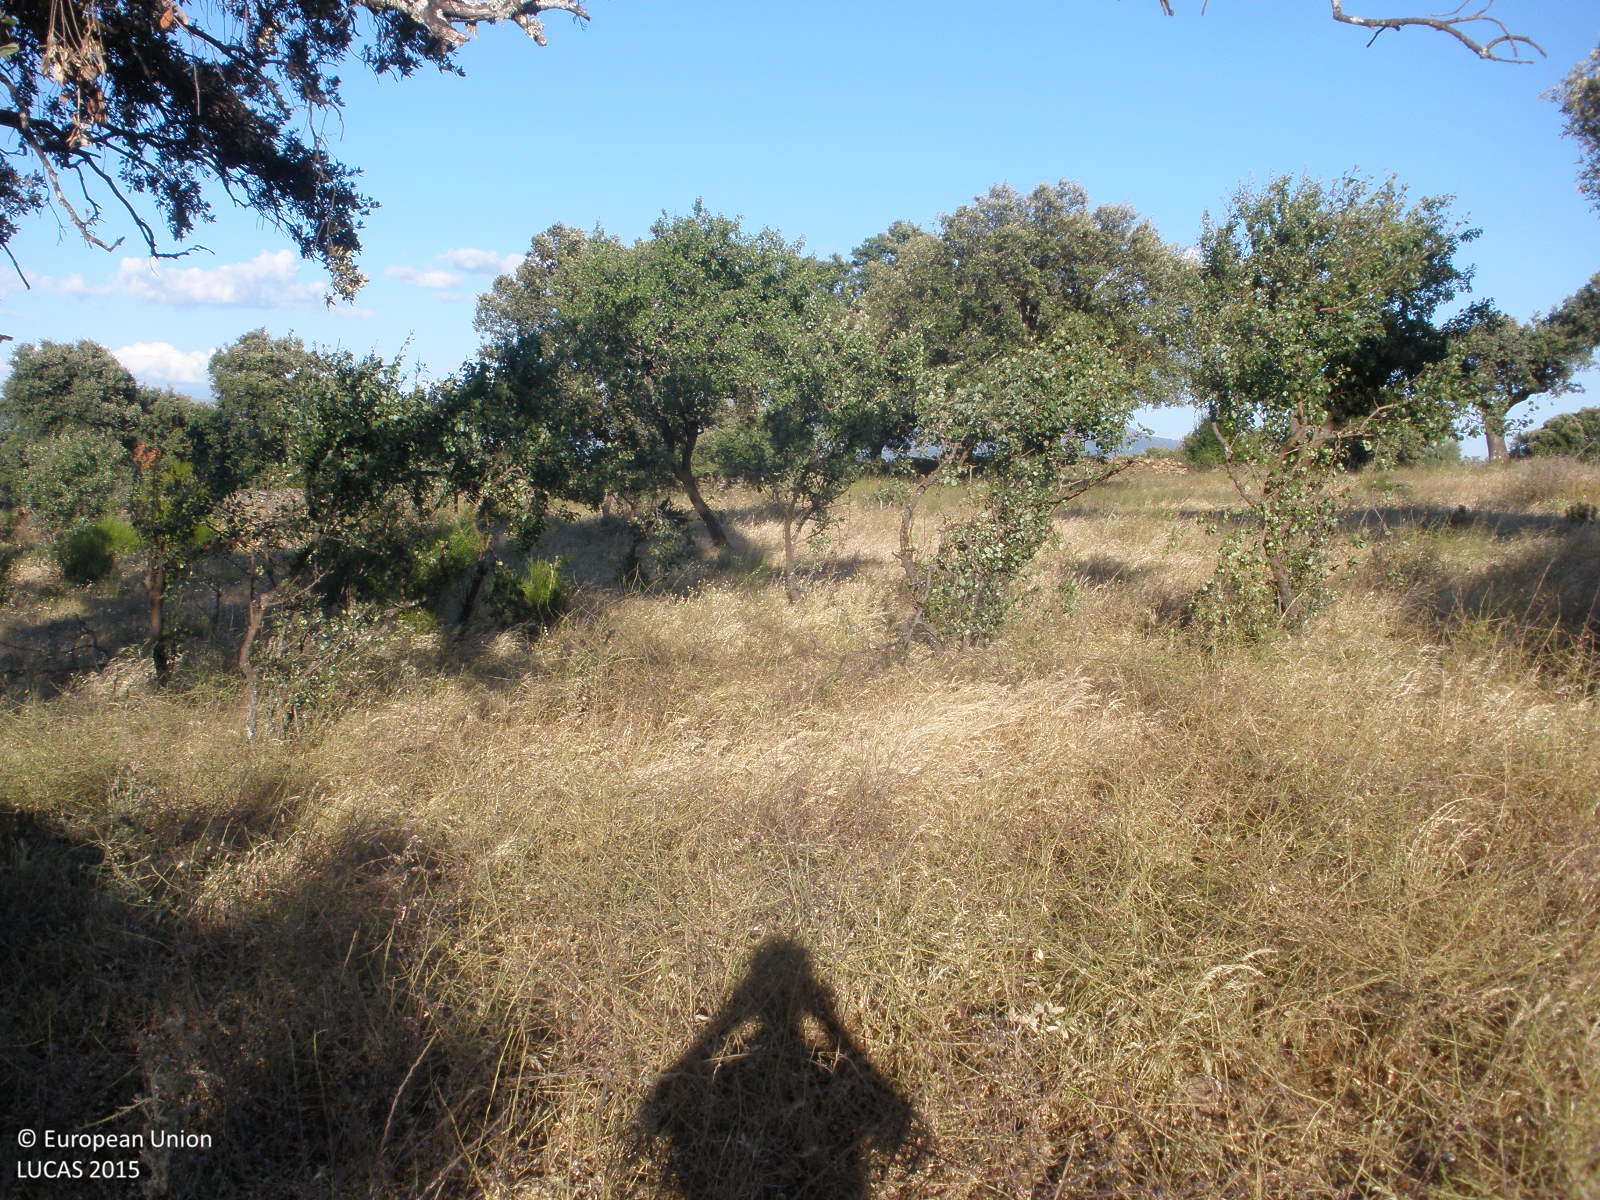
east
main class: Woodland
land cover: Broadleaved woodland
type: broadleaved evergreen forest
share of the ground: 25 - 50 %
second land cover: Grassland without tree/shrub cover
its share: > 75 %
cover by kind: herbaceous plants 60 %, broadleaved forest trees 40 %
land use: Forestry
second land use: Agriculture (excluding fallow land and kitchen gardens)
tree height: > 5 m
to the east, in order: Broadleaved woodland; Grassland without tree/shrub cover; Dry stone walls; Tracks; Dry stone walls; Fences; Broadleaved woodland; Fences; Dry stone walls; Broadleaved woodland; Dry stone walls; Grassland with sparse tree/shrub cover; Shrubland without tree cover; Broadleaved woodland
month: May
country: ES
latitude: 40.1885
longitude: -6.1551
